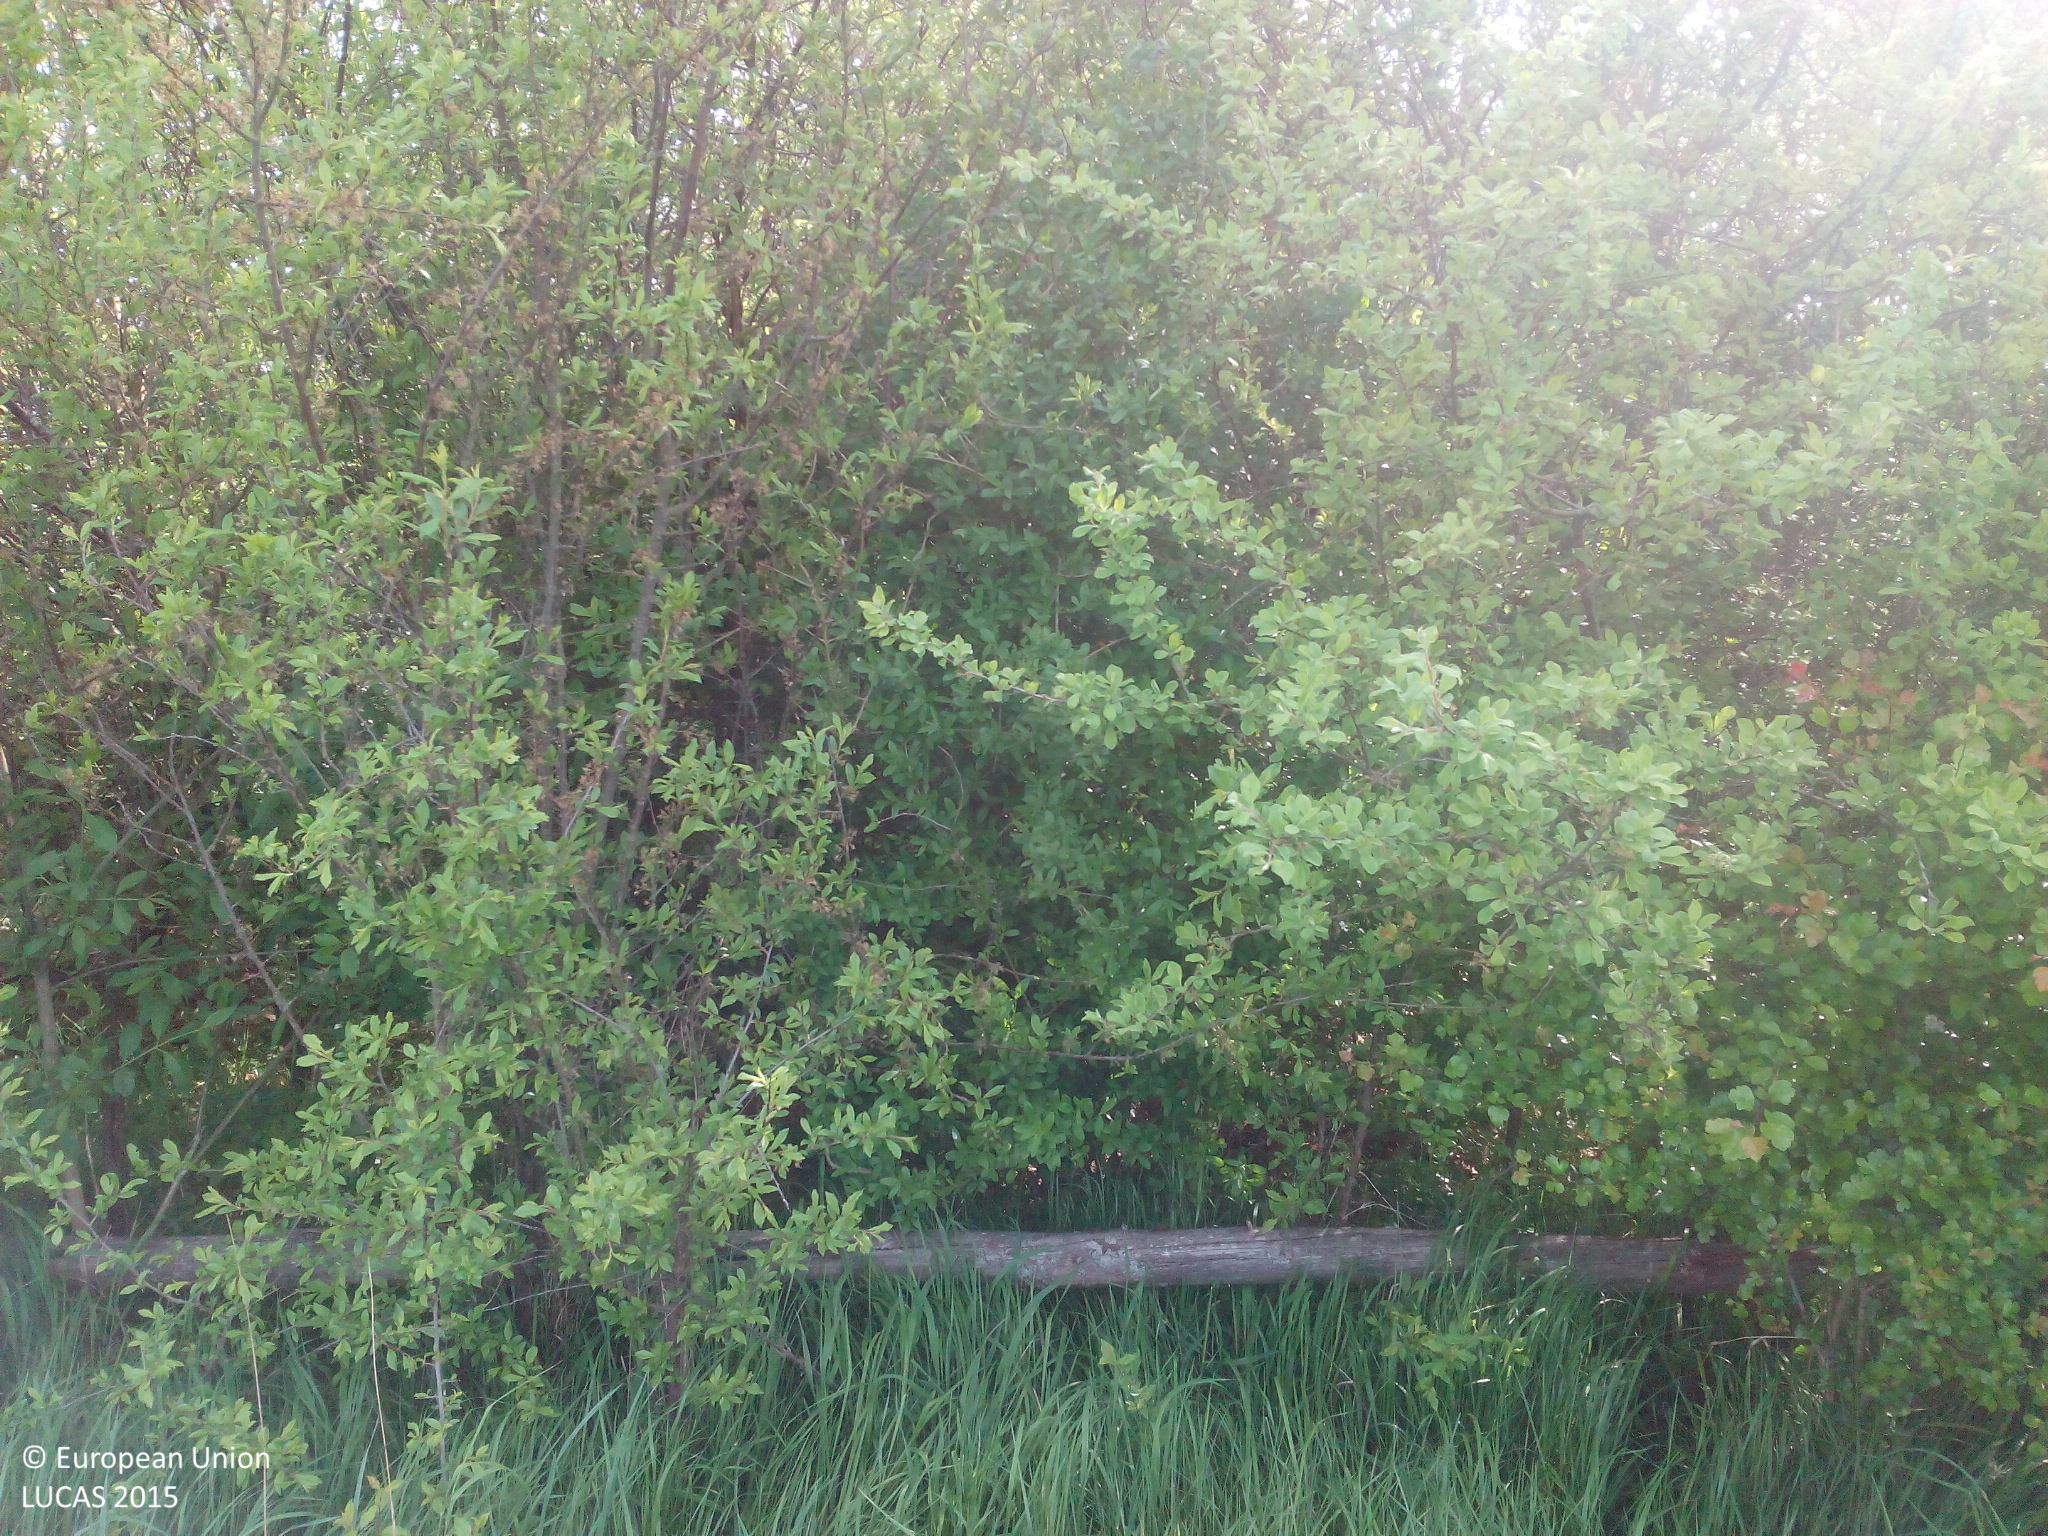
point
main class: Shrubland
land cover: Shrubland with sparse tree cover
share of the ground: > 75 %
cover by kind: shrubs 95 %, broadleaved forest trees 5 %
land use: Semi-natural and natural areas not in use
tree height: < 5 m
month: May
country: DE
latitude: 49.9227
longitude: 11.4900
